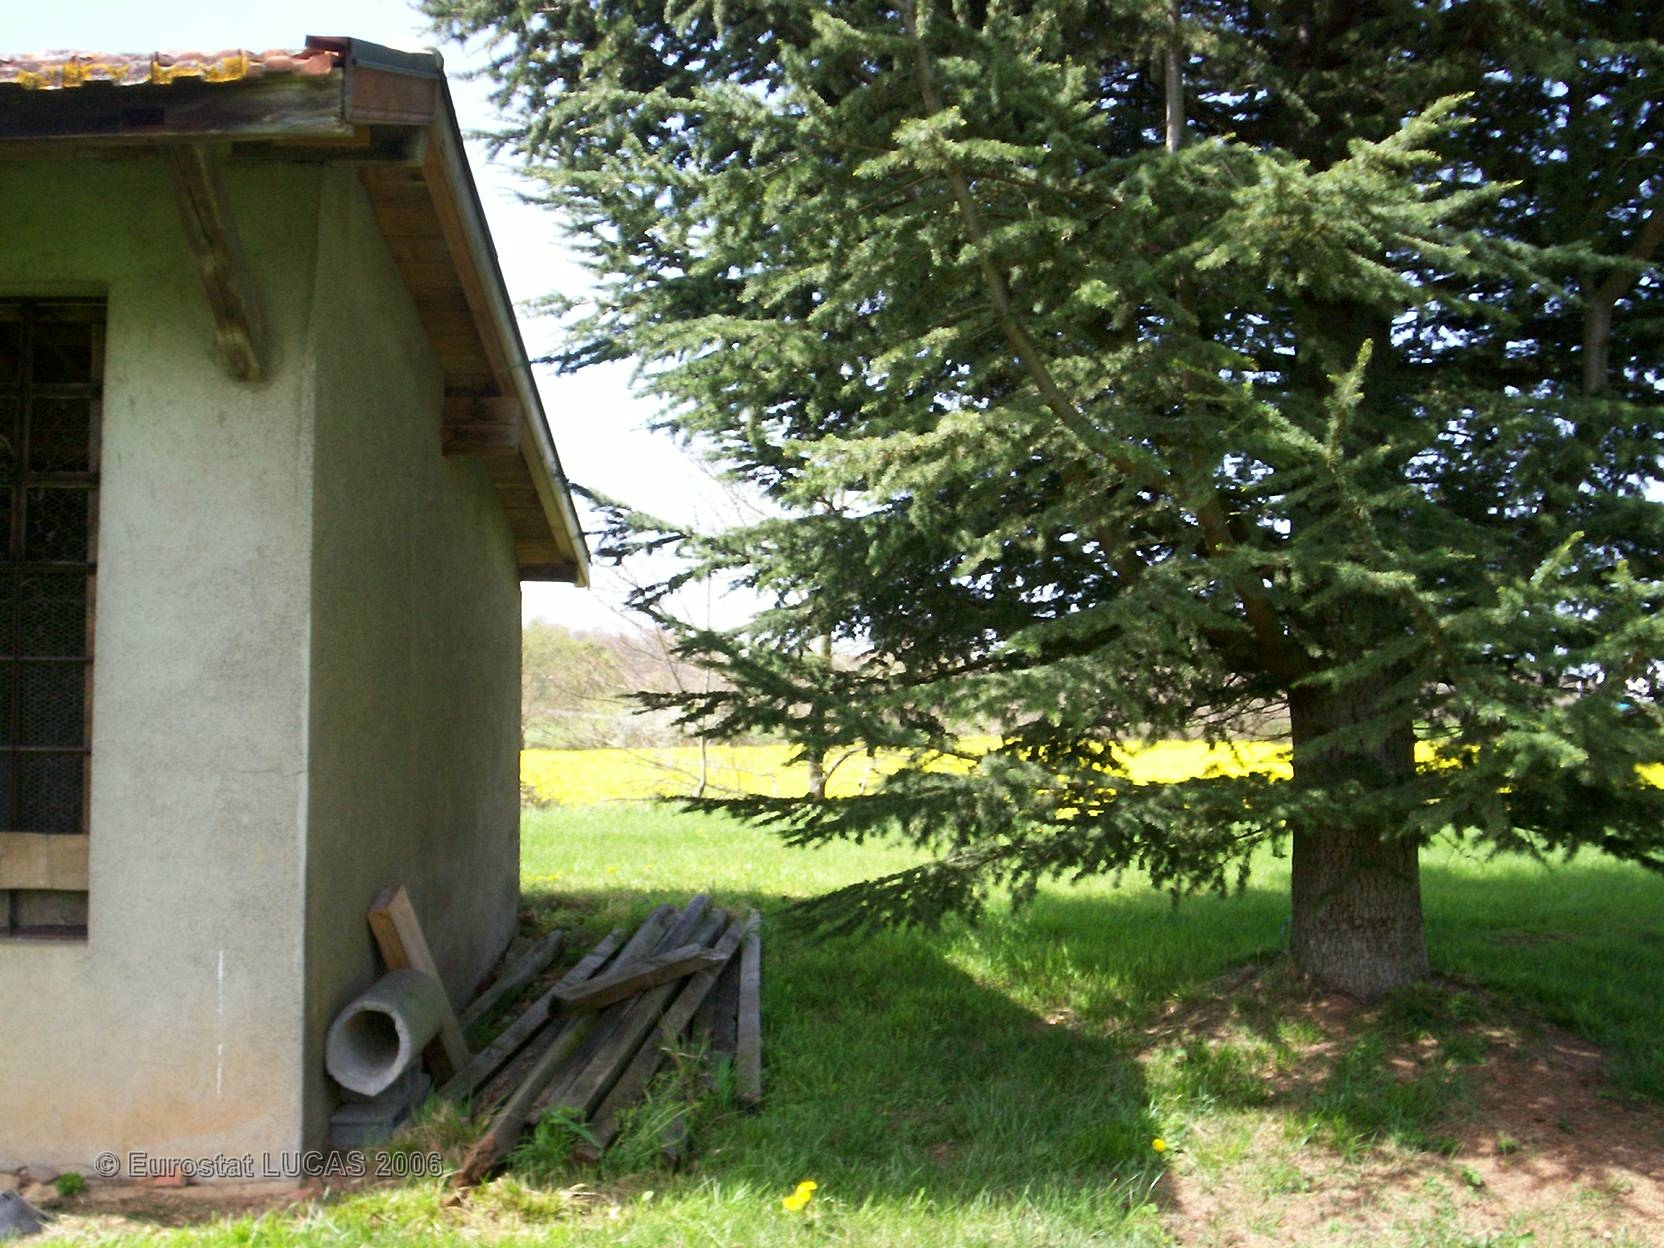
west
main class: Grassland
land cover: Grassland with sparse tree/shrub cover
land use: Residential
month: April
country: FR
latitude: 43.4184
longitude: 0.2521
